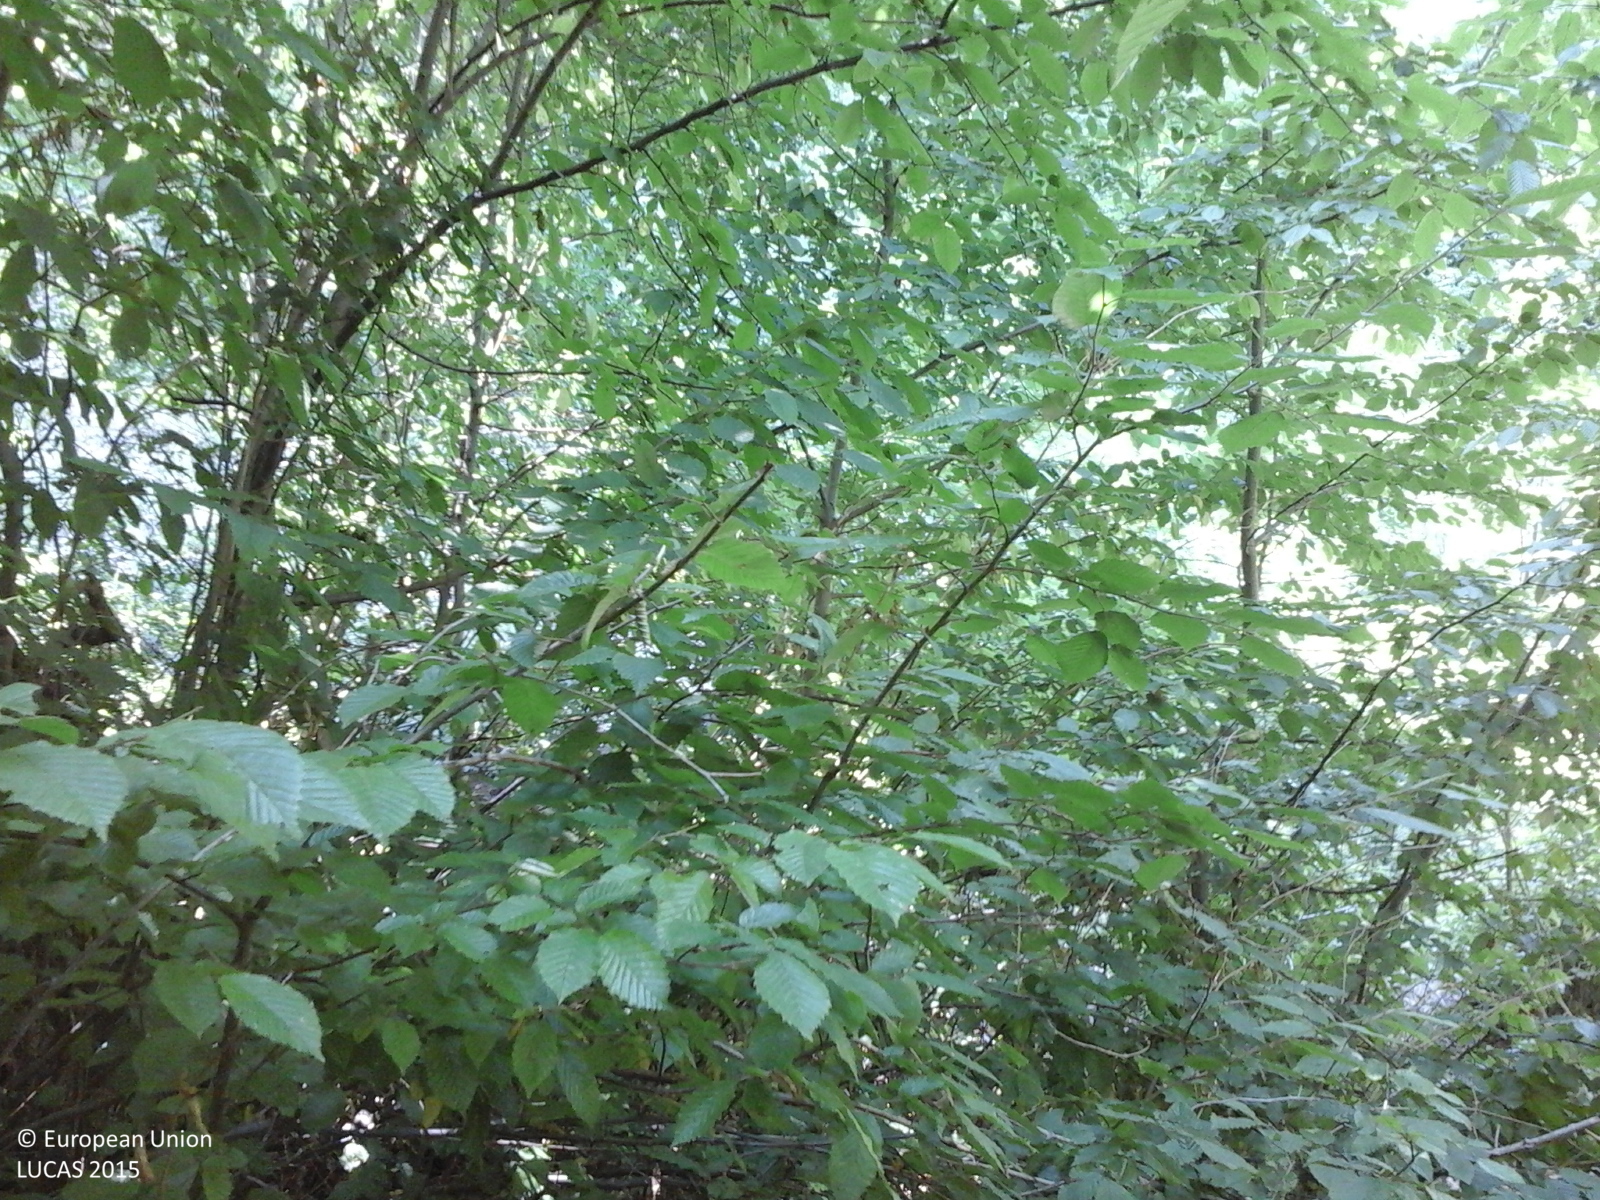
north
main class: Woodland
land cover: Broadleaved woodland
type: acidophilous oak and oak-birch forest
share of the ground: > 75 %
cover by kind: broadleaved forest trees 100 %
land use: Forestry
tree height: > 5 m
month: July
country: RO
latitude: 44.9066
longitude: 24.4487
